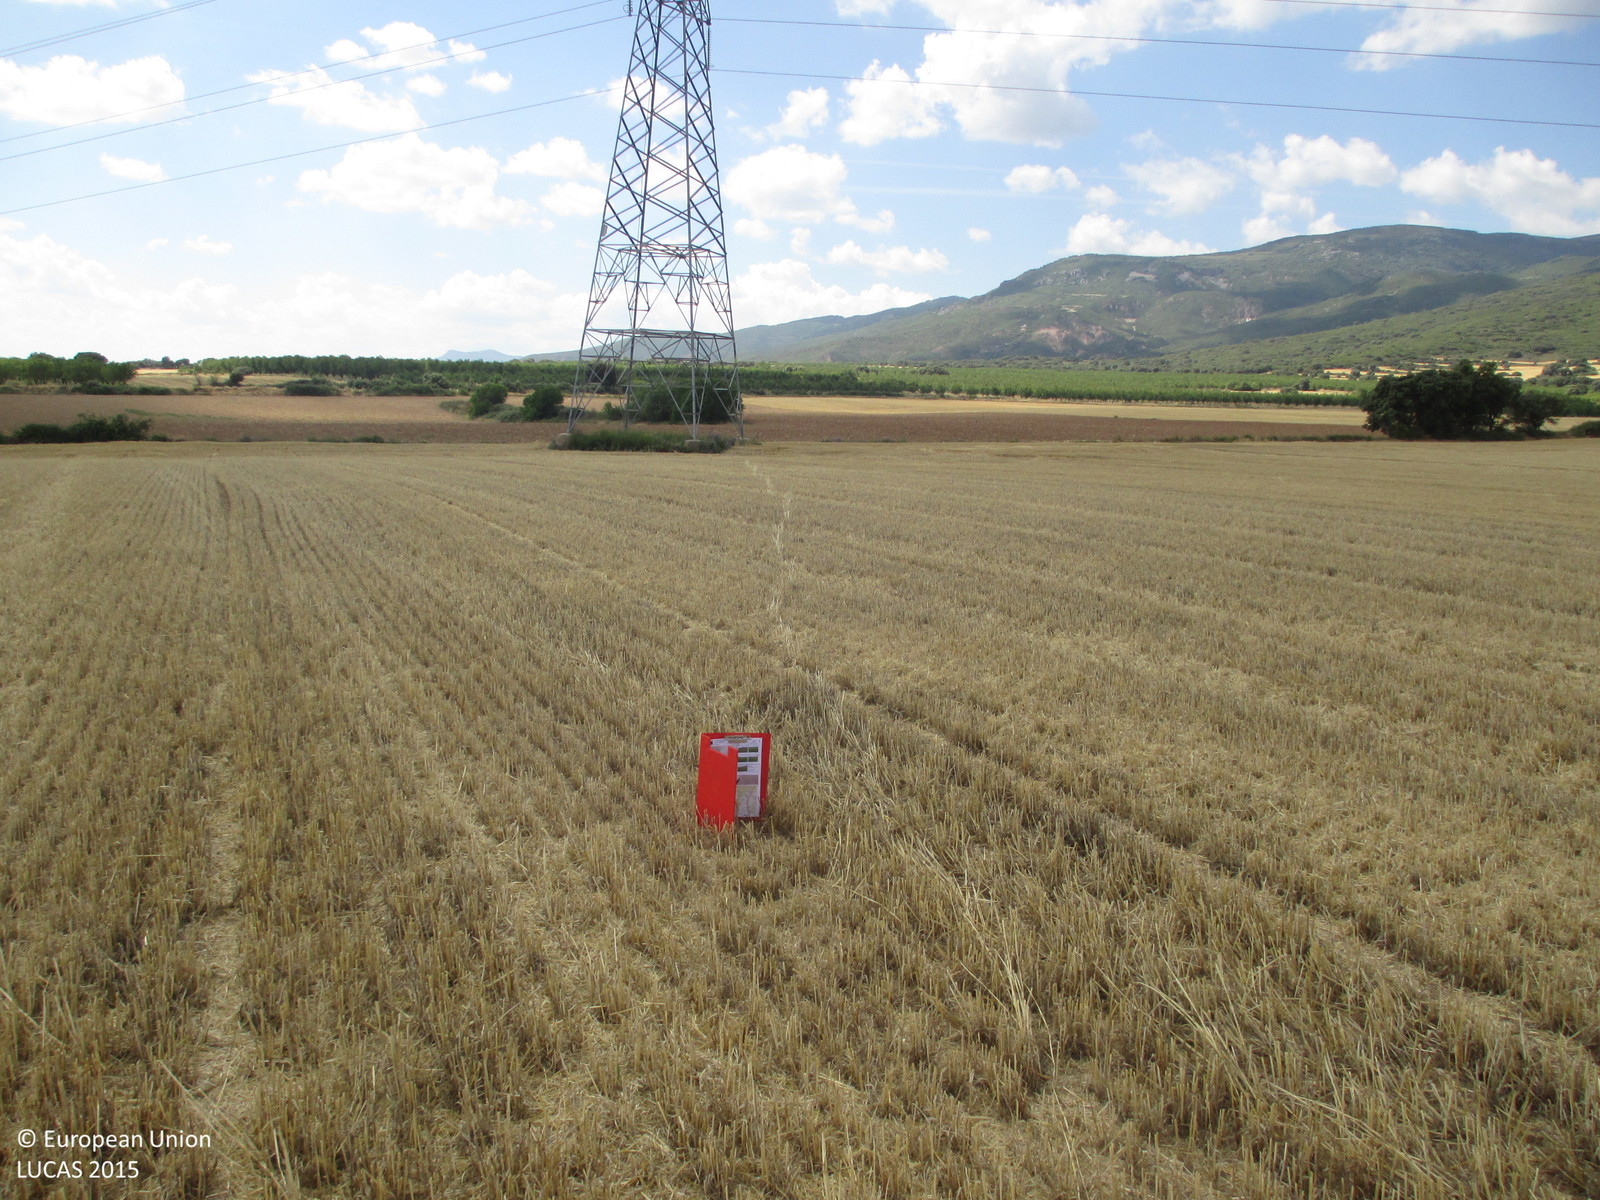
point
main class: Cropland
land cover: Barley
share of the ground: < 10 %
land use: Agriculture (excluding fallow land and kitchen gardens)
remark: Harvested field
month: June
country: ES
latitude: 42.2540
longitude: -0.4846
